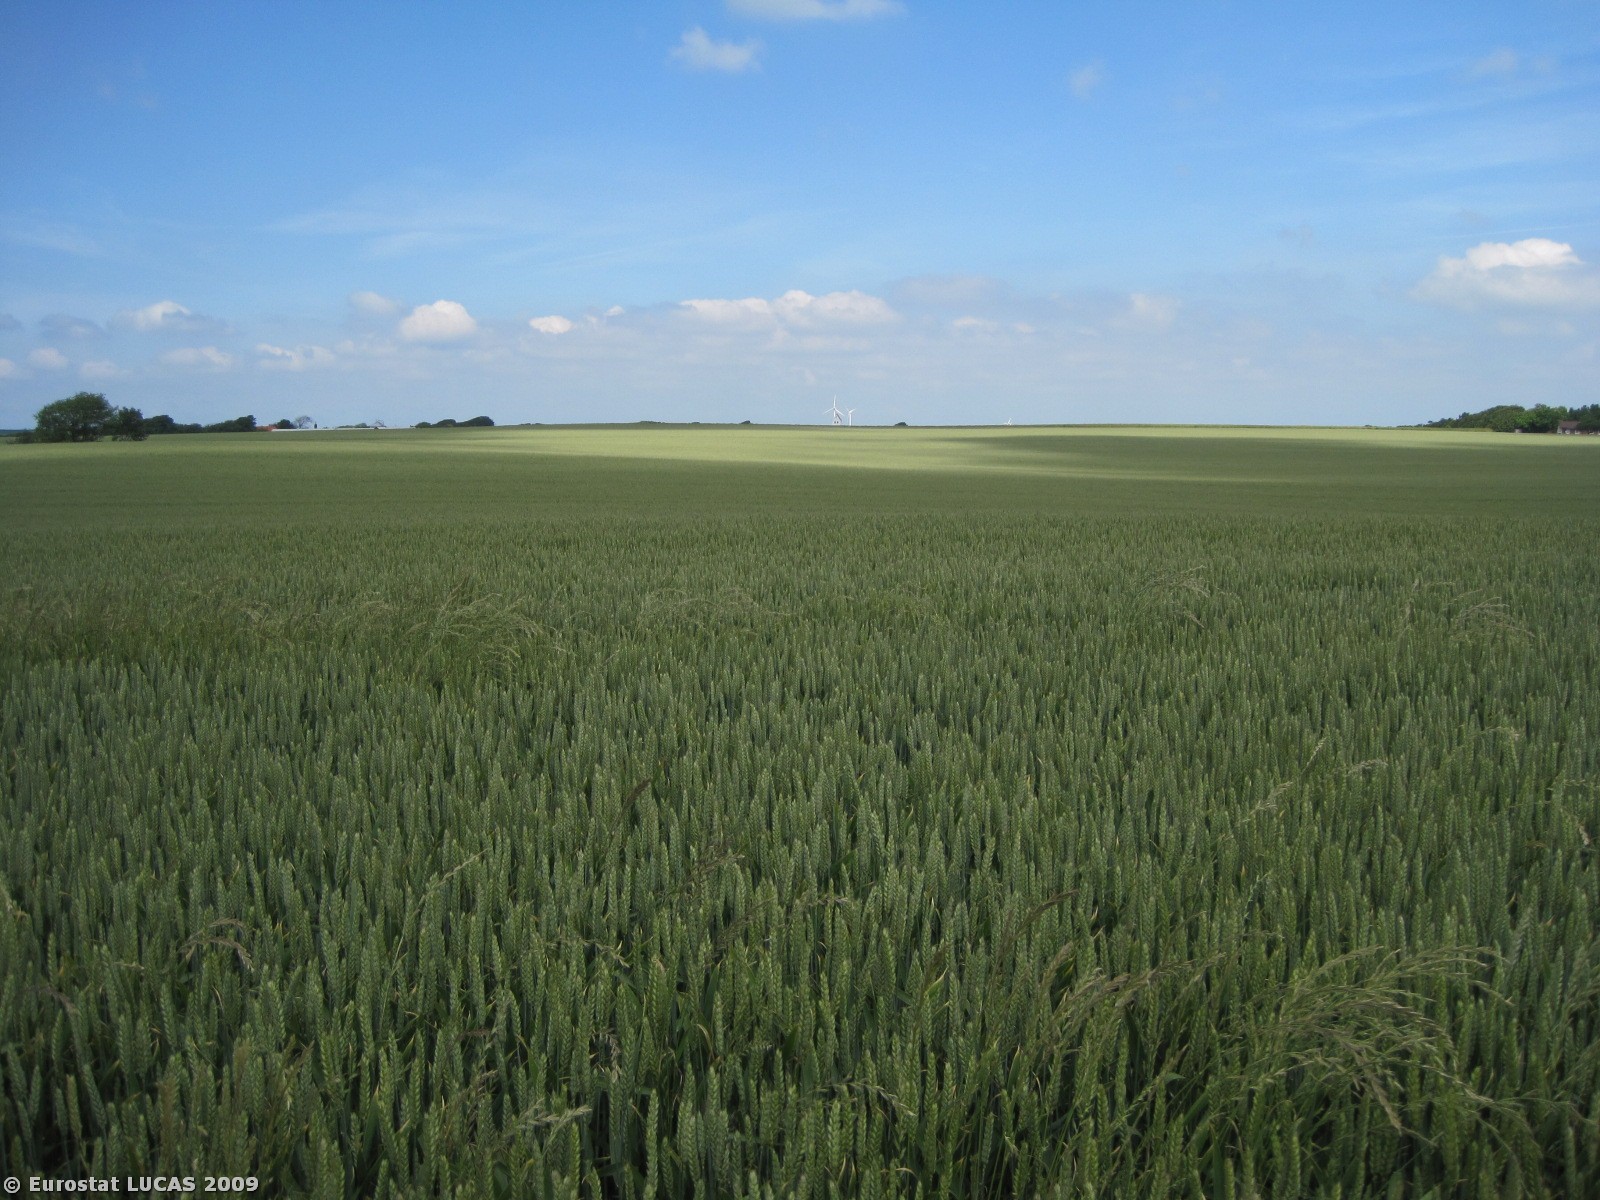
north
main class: Cropland
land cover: Common wheat
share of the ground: > 75 %
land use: Agriculture (excluding fallow land and kitchen gardens)
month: June
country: DK
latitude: 56.5775
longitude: 8.7807
